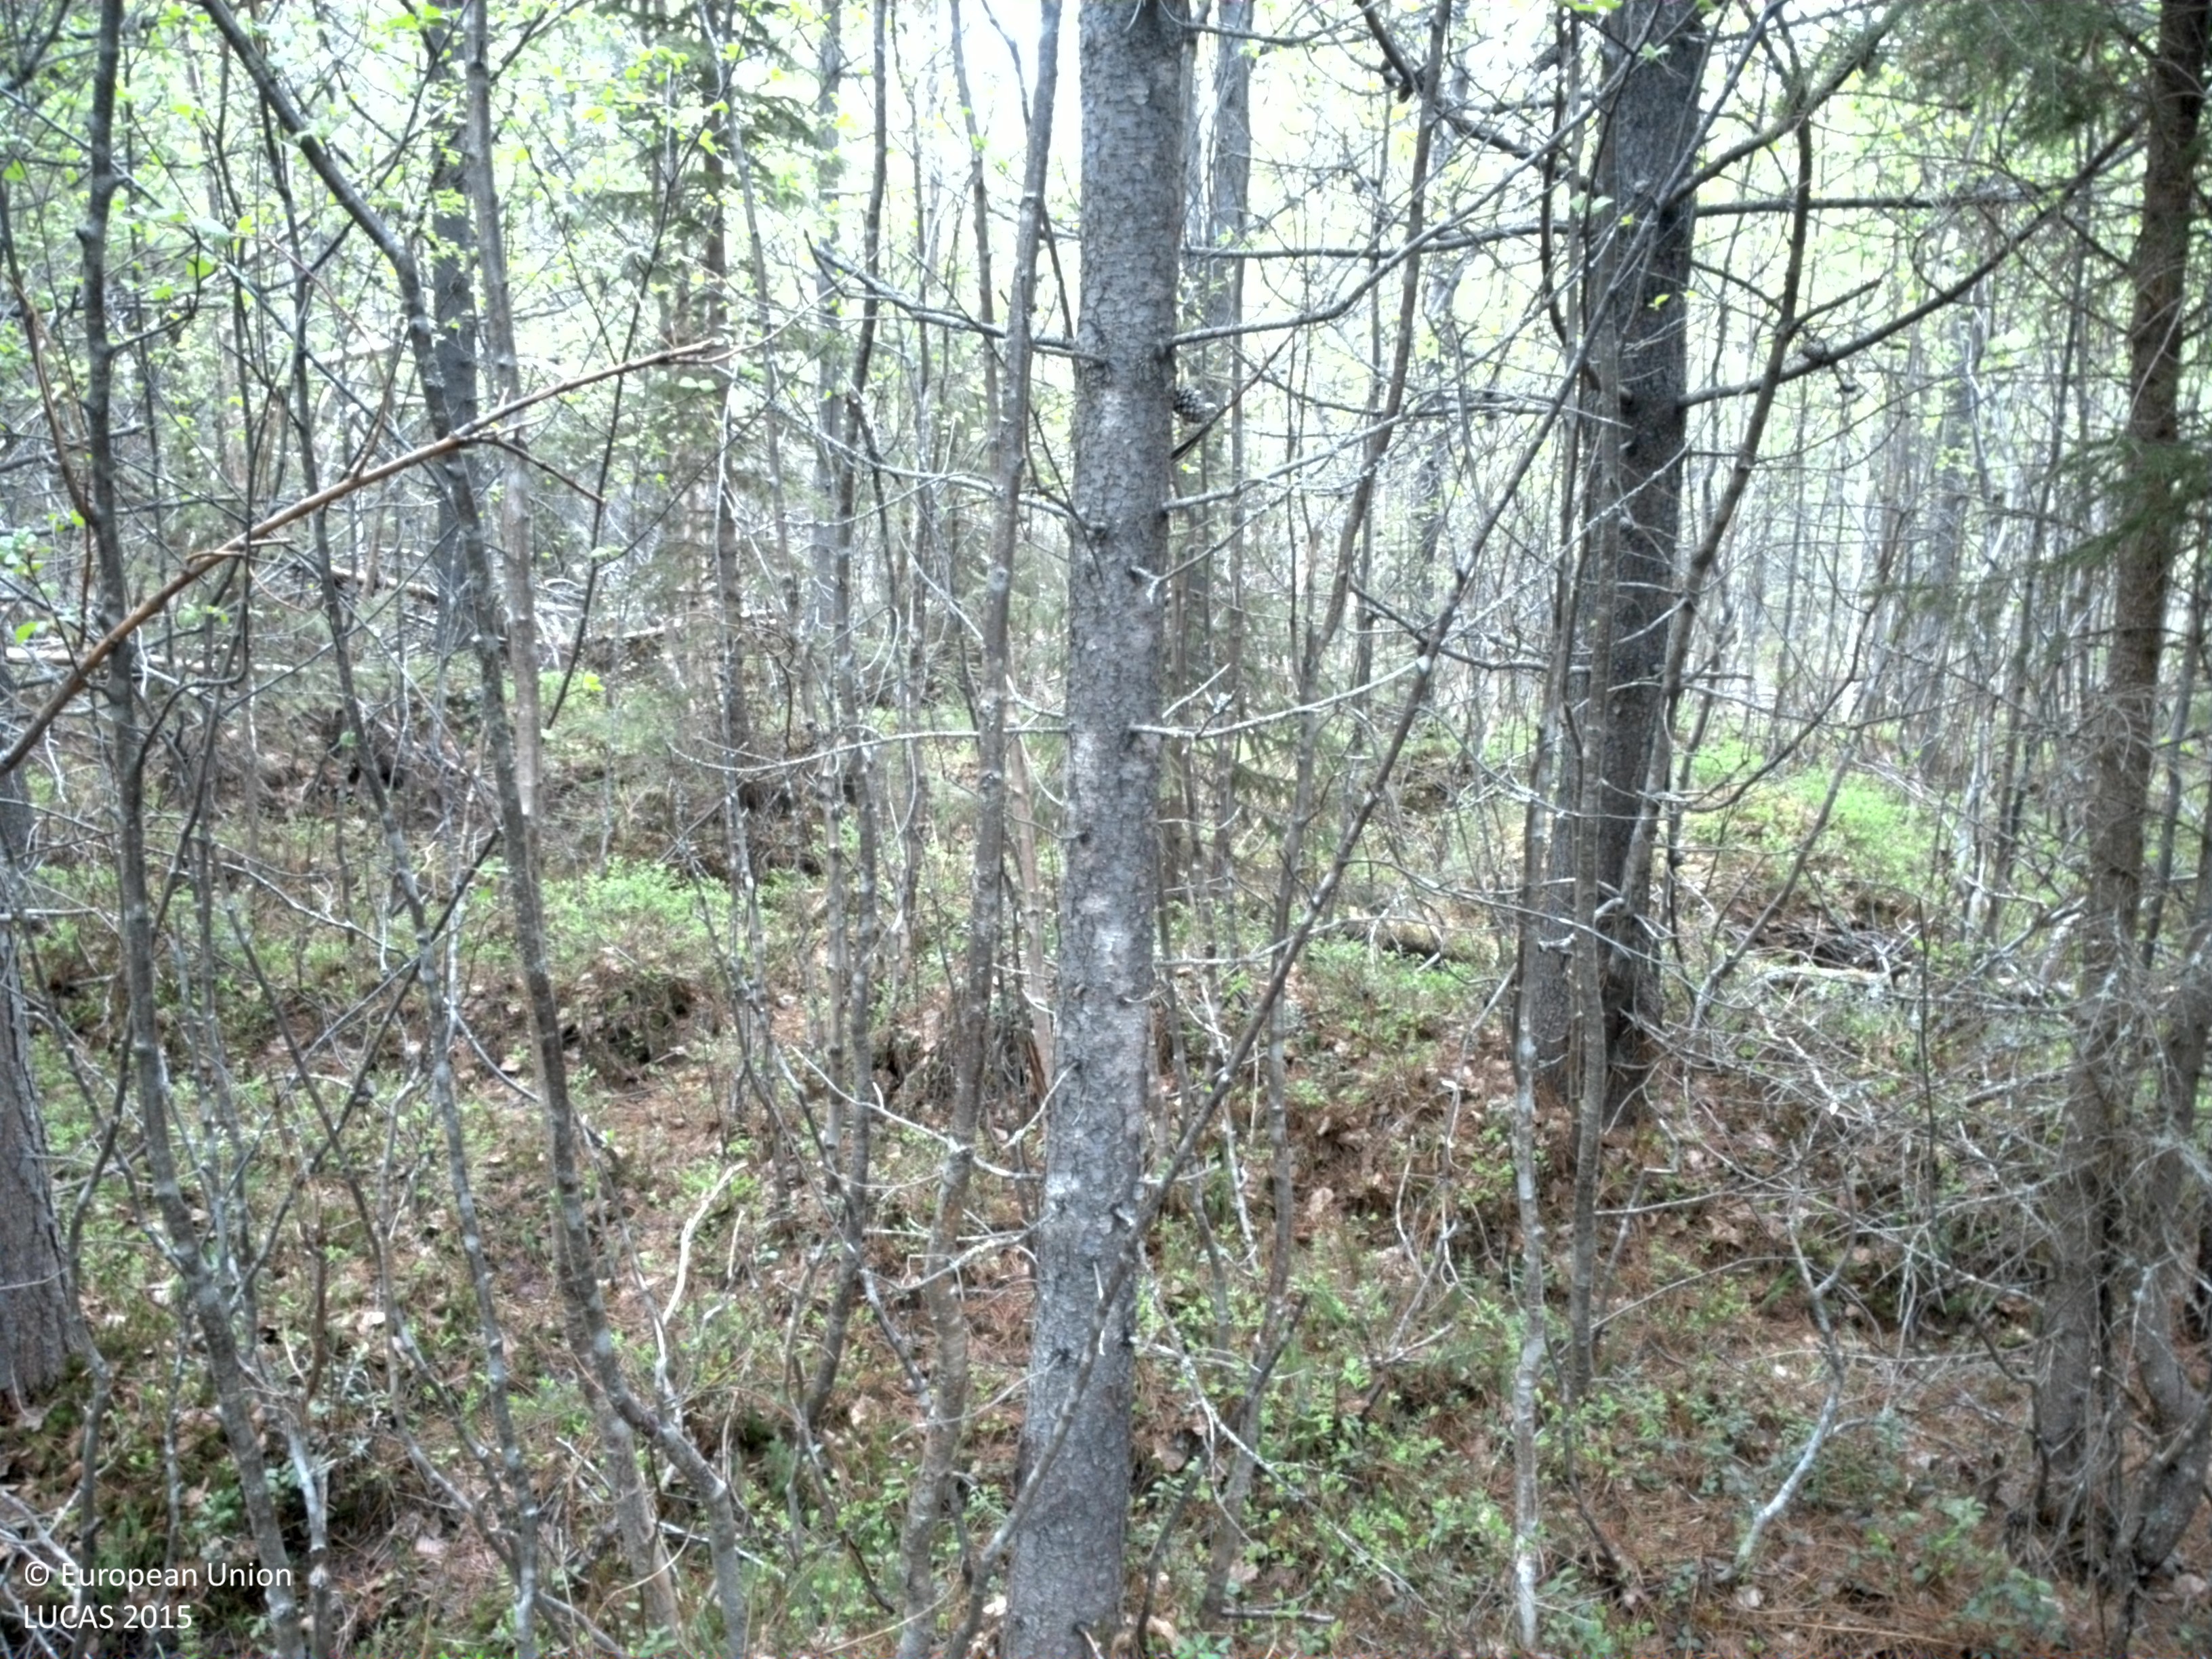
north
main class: Woodland
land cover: Pine dominated mixed woodland
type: exotic forest
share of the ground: > 75 %
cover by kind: coniferous forest trees 55 %, broadleaved forest trees 30 %, shrubs 15 %
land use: Forestry
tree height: > 5 m
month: June
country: SE
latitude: 66.3668
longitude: 22.4242
